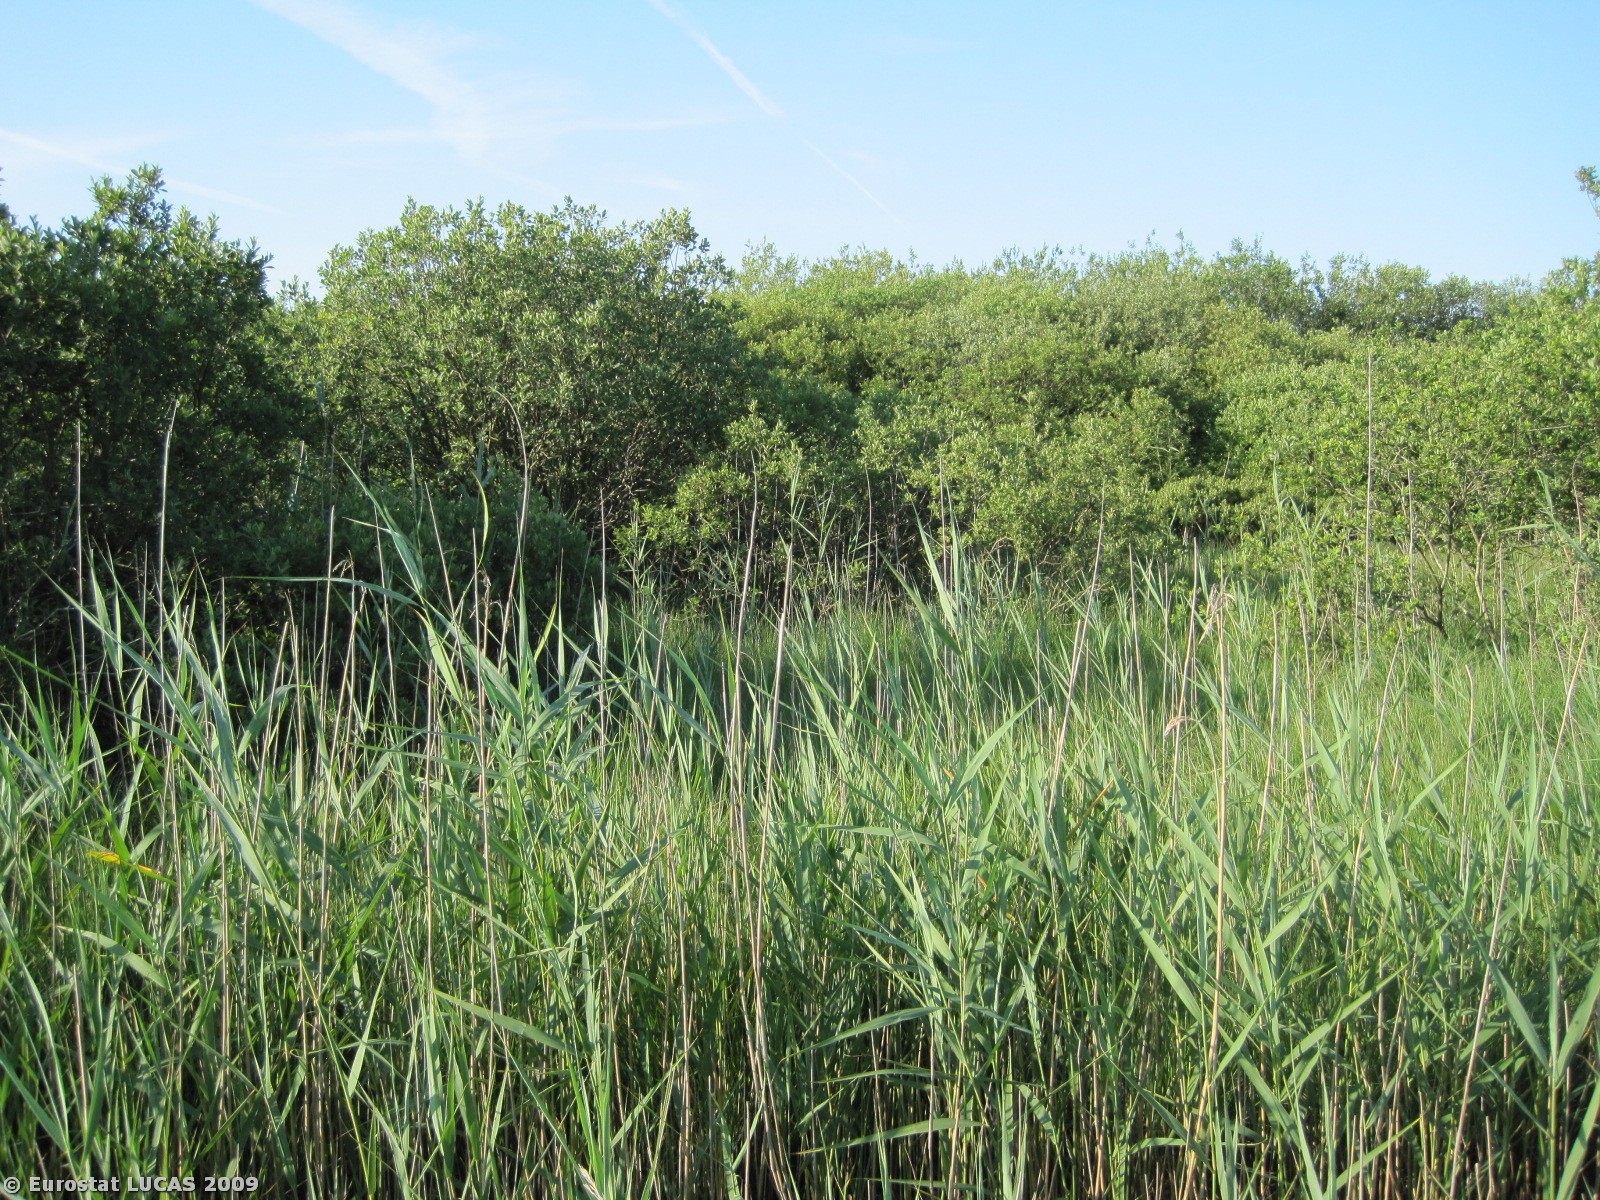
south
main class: Wetlands
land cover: Inland marshes
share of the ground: > 75 %
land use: Unused
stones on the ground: < 10 %
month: July
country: DK
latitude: 56.3739
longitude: 8.2695
